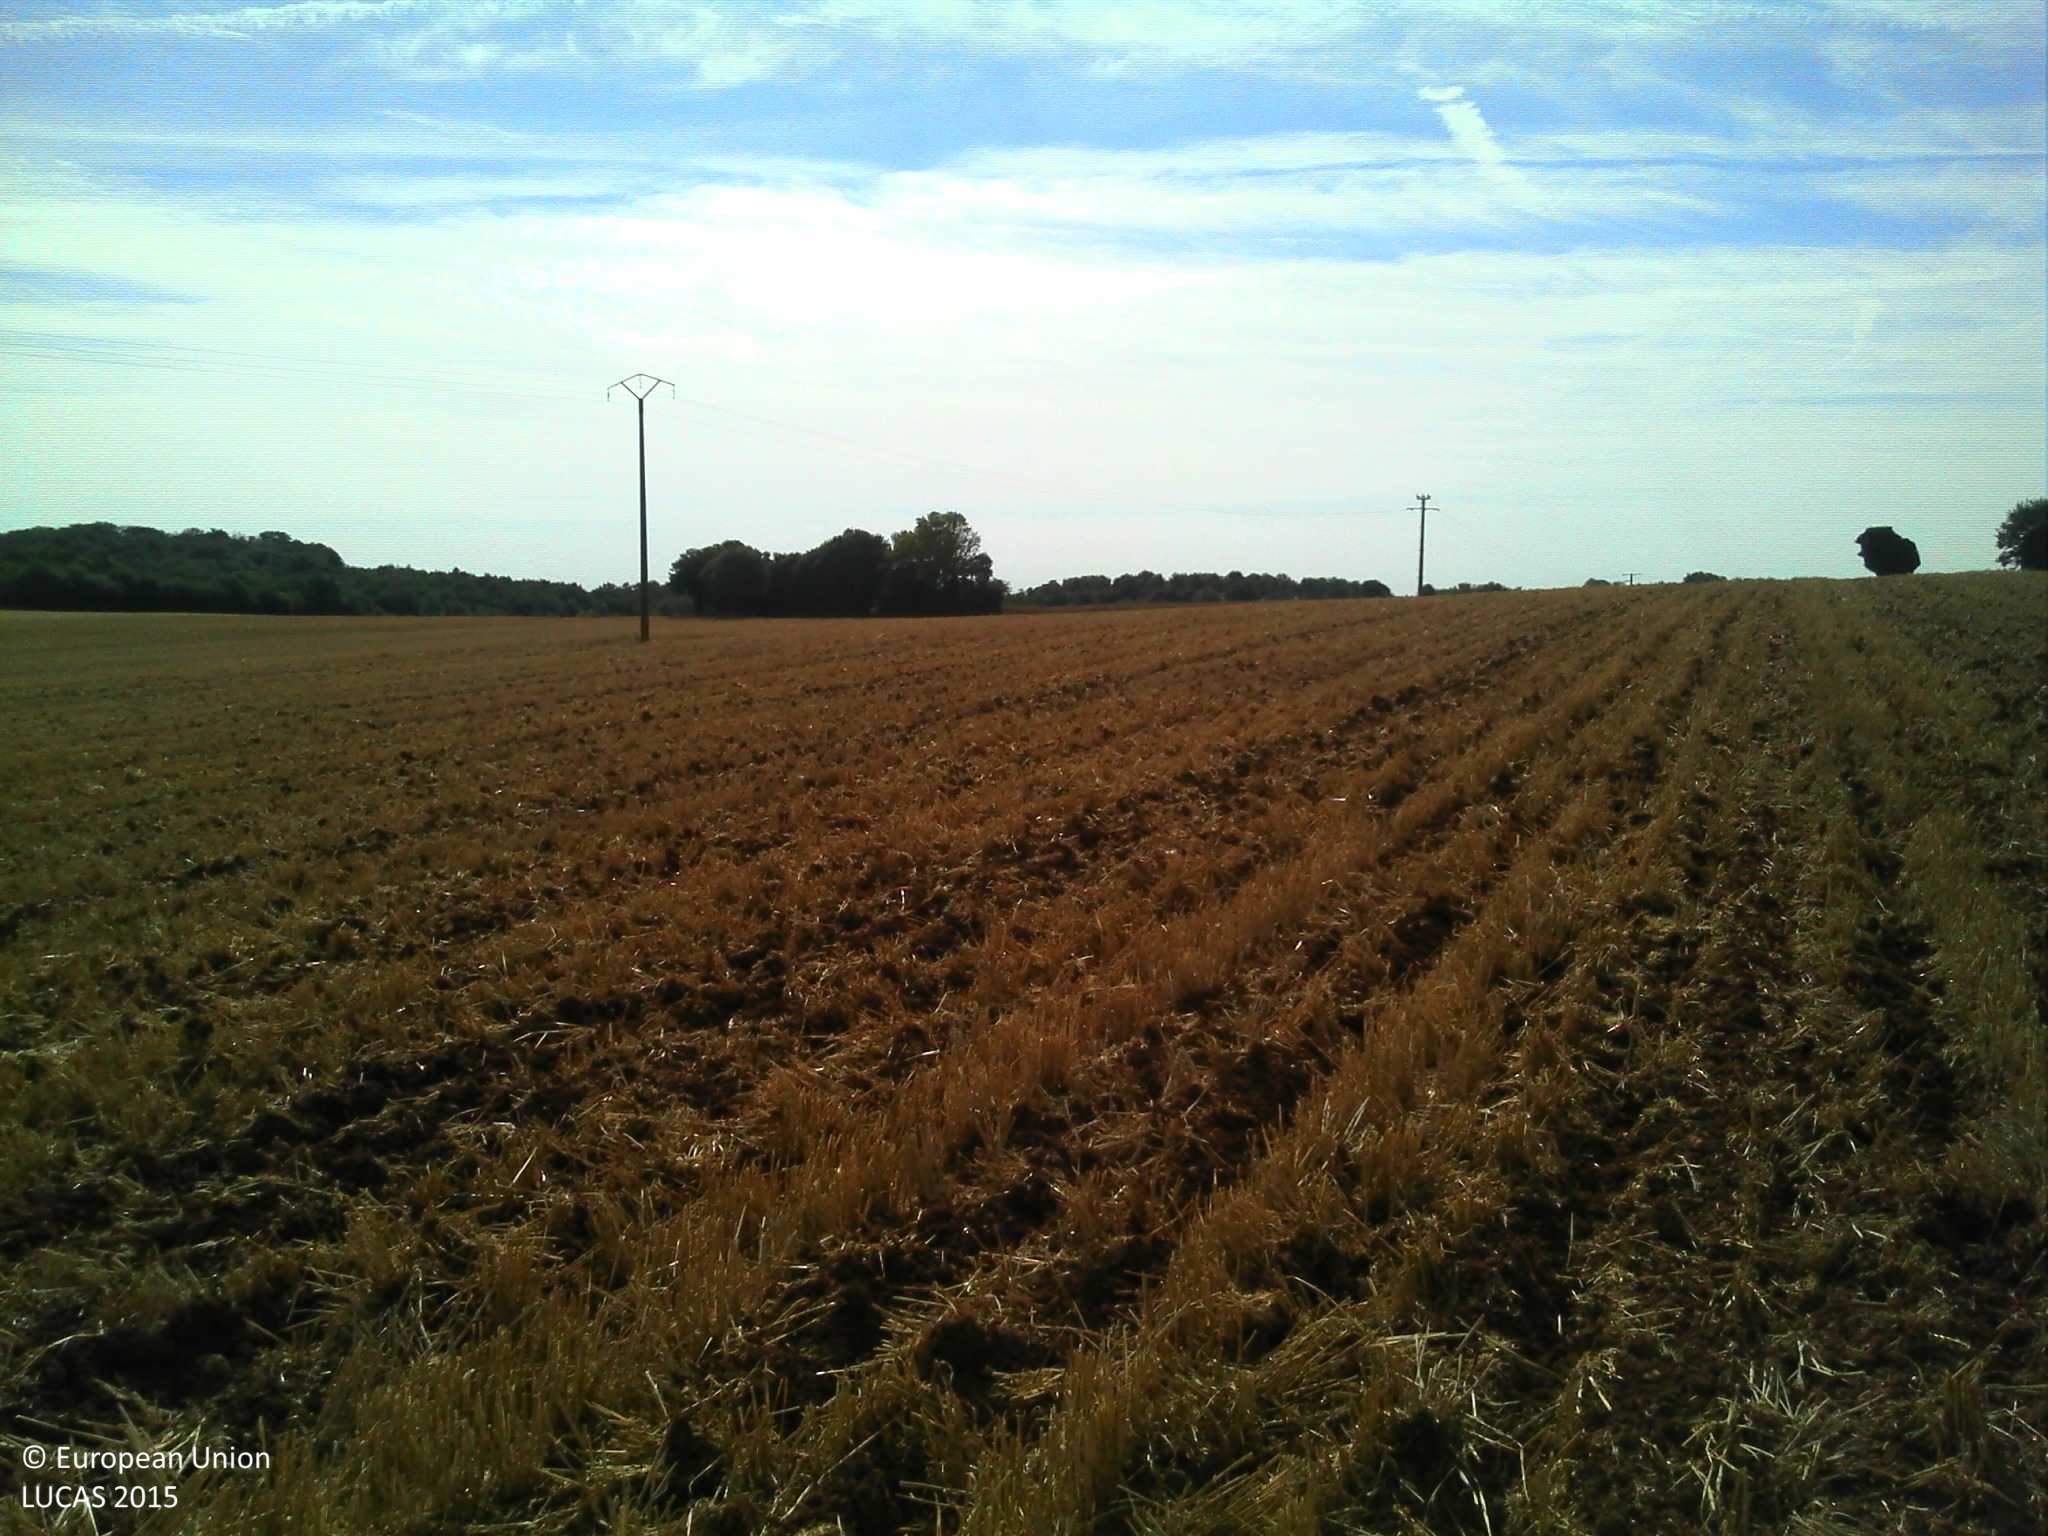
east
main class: Cropland
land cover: Barley
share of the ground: < 10 %
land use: Agriculture (excluding fallow land and kitchen gardens)
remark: Harvested field
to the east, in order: Barley; Electric lines; Barley
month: June
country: FR
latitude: 46.4875
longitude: 0.2755
